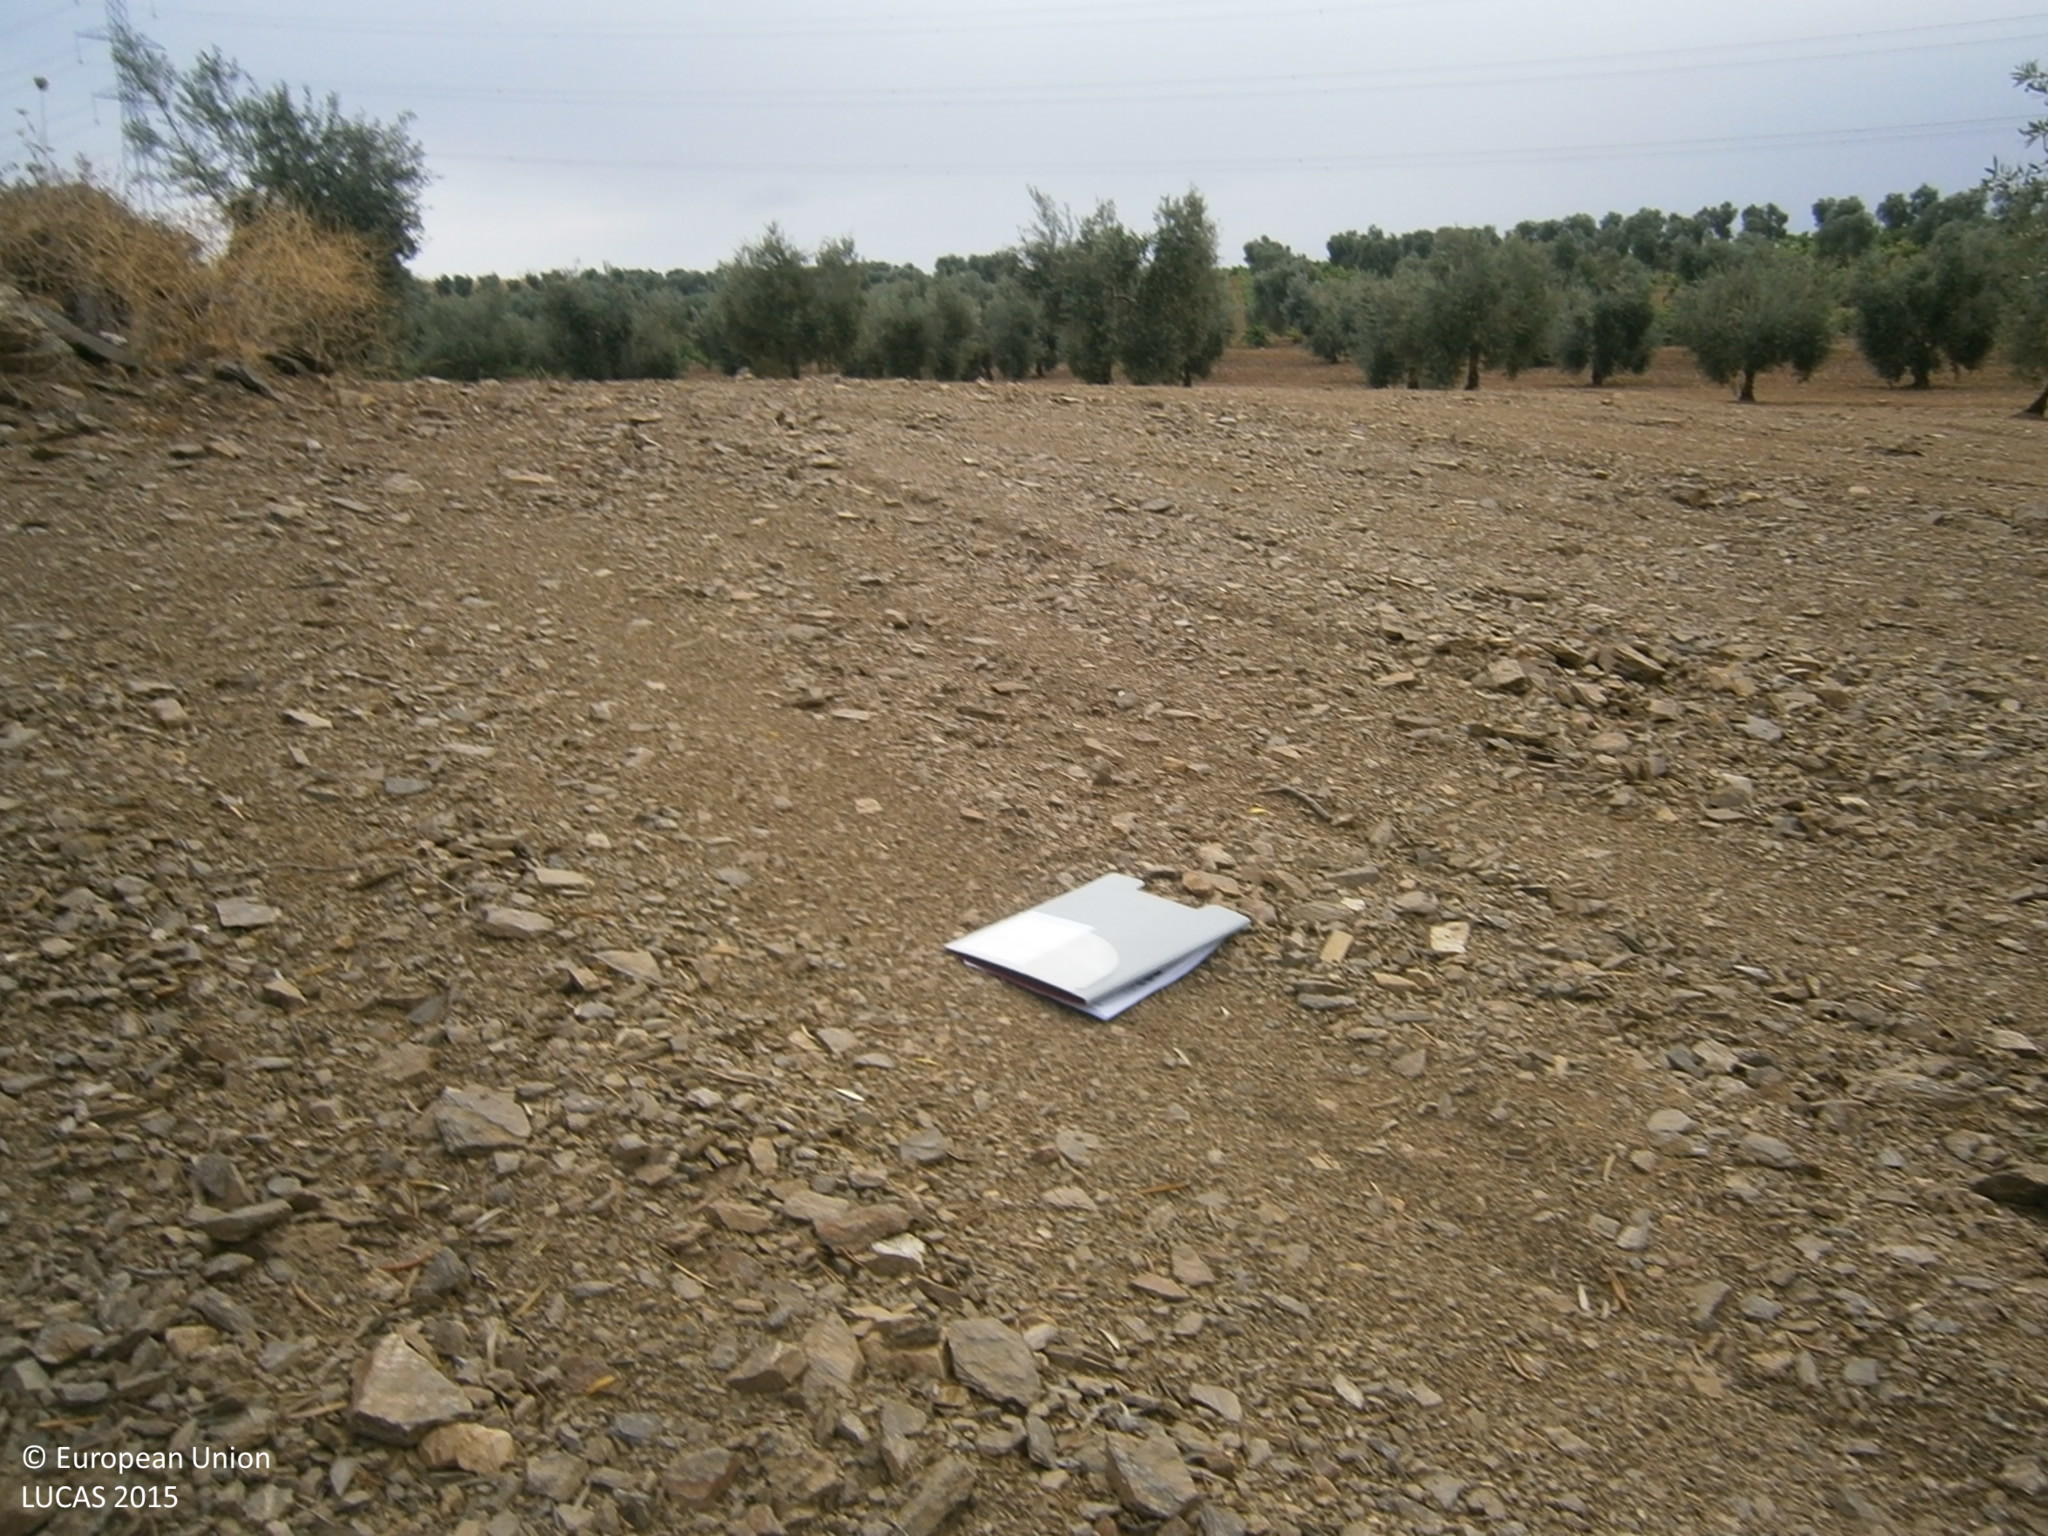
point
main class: Cropland
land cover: Olive groves
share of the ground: 10 - 25 %
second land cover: Other bare soil
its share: > 75 %
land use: Agriculture (excluding fallow land and kitchen gardens)
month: June
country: ES
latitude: 38.5899
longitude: -6.4600
